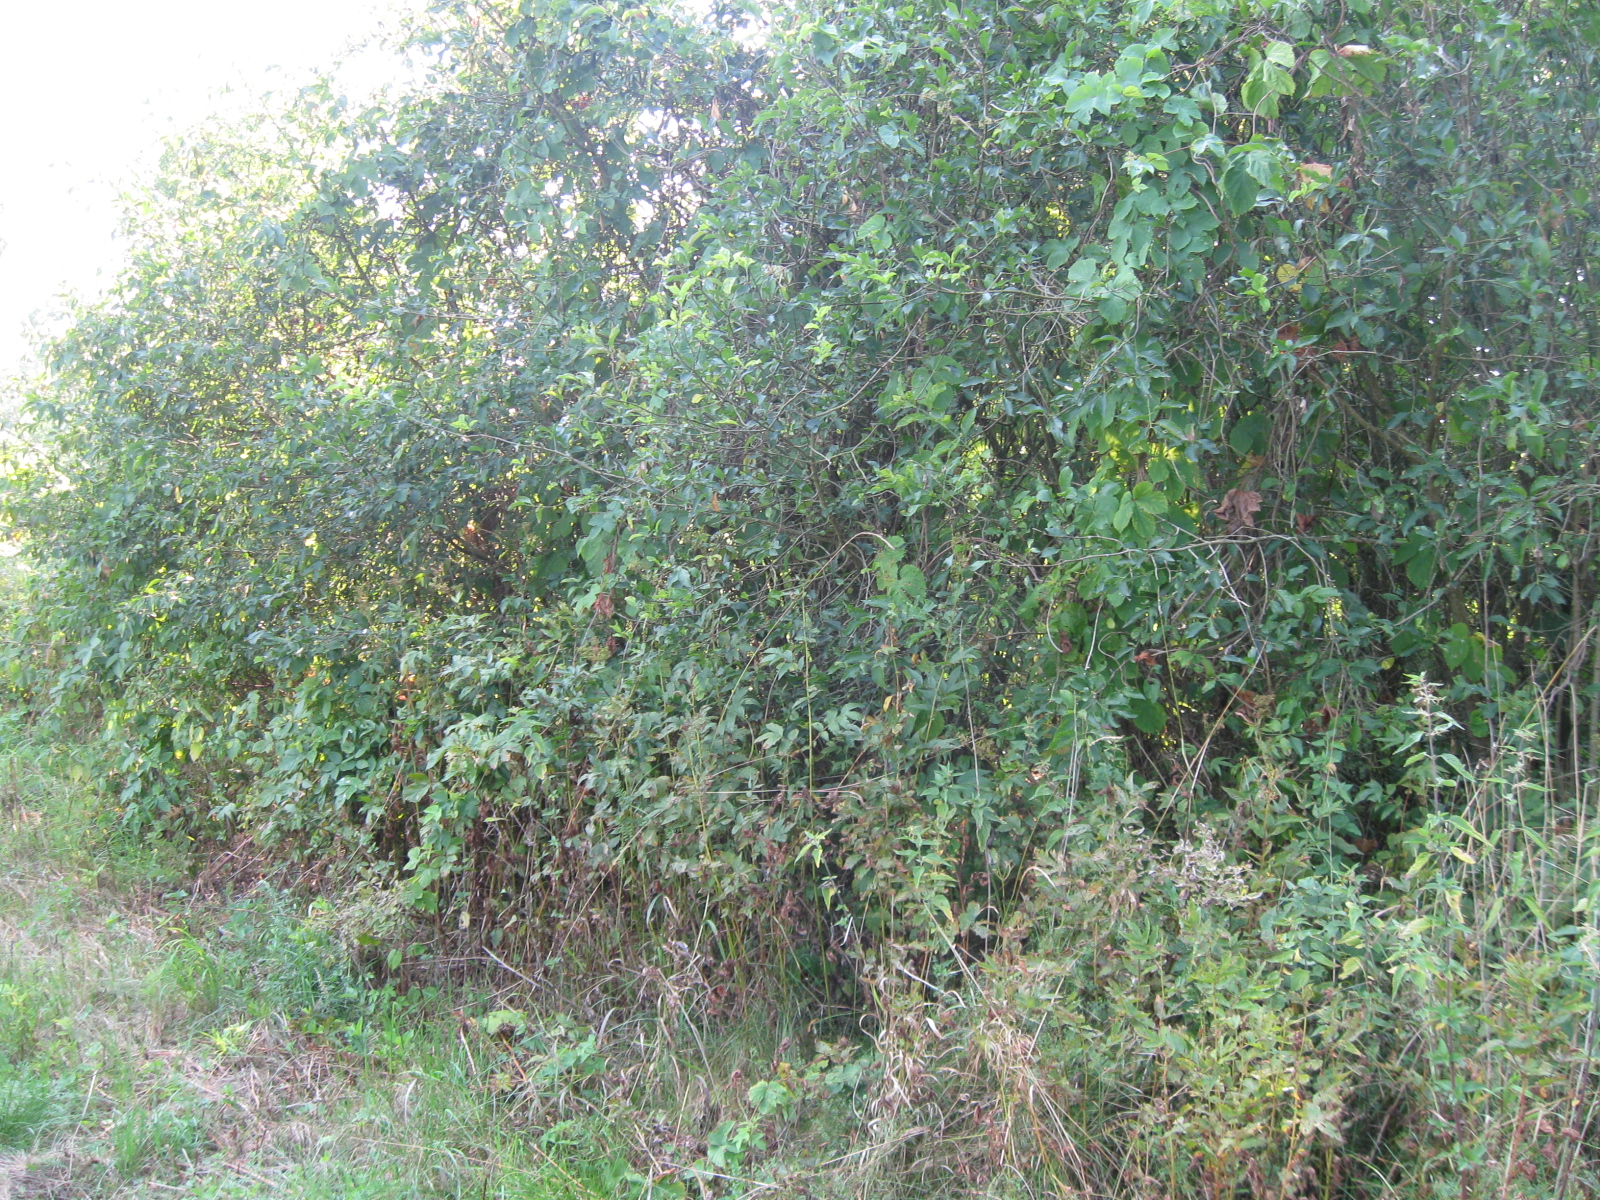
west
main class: Grassland
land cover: Grassland without tree/shrub cover
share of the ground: > 75 %
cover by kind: herbaceous plants 90 %, unconsolidated bare surface 10 %
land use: Agriculture (excluding fallow land and kitchen gardens)
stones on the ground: < 10 %
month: August
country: LT
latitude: 54.7369
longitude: 23.3580
